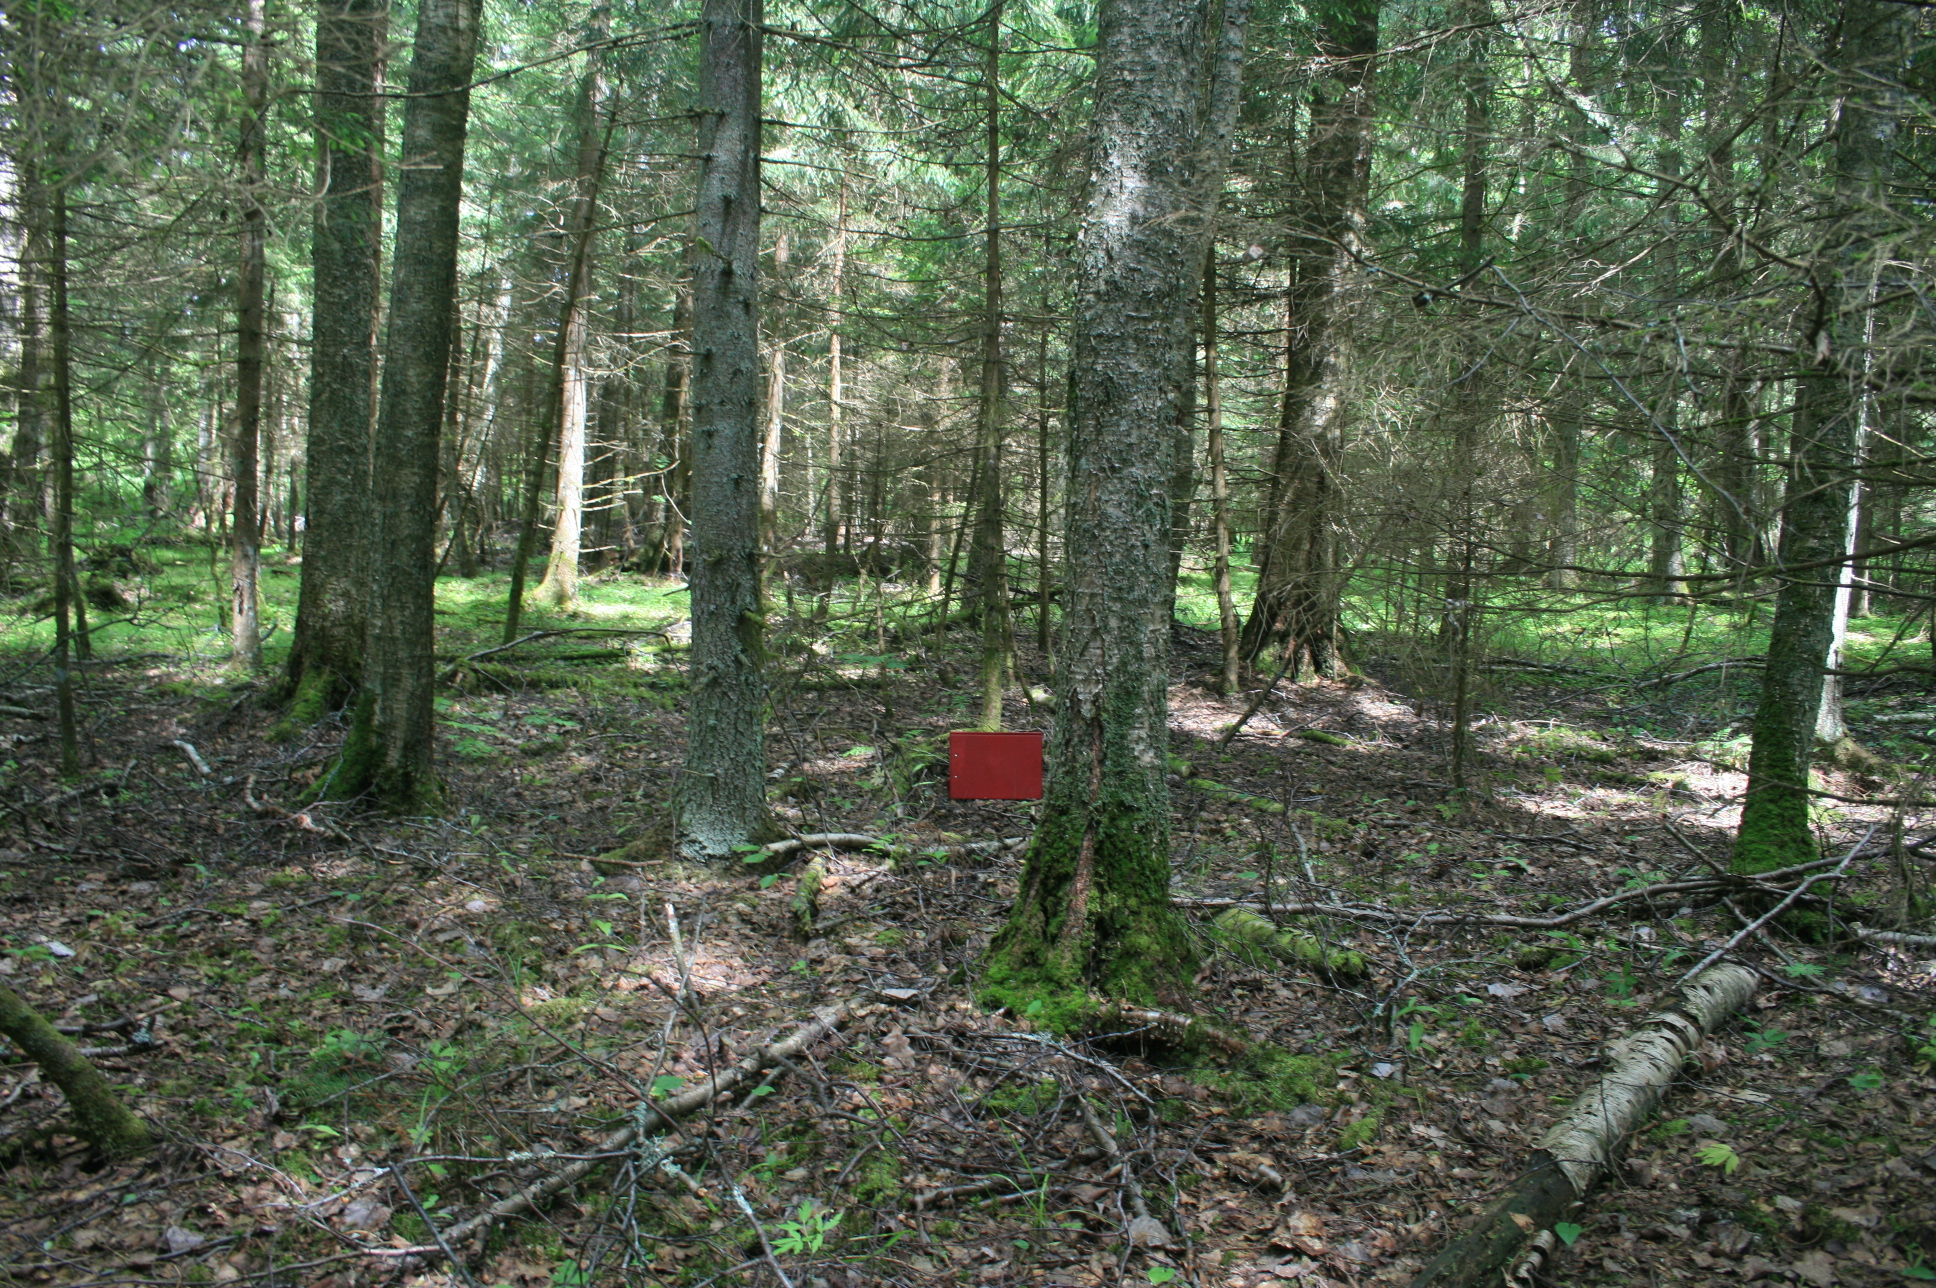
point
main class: Woodland
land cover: Spruce dominated mixed woodland
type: hemiboreal forest and nemoral coniferous forest and mixed broadleaved-coniferous forest
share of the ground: > 75 %
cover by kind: broadleaved forest trees 50 %, coniferous forest trees 40 %, herbaceous plants 10 %
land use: Forestry
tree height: > 5 m
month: June
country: LT
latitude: 55.2996
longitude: 22.1366
